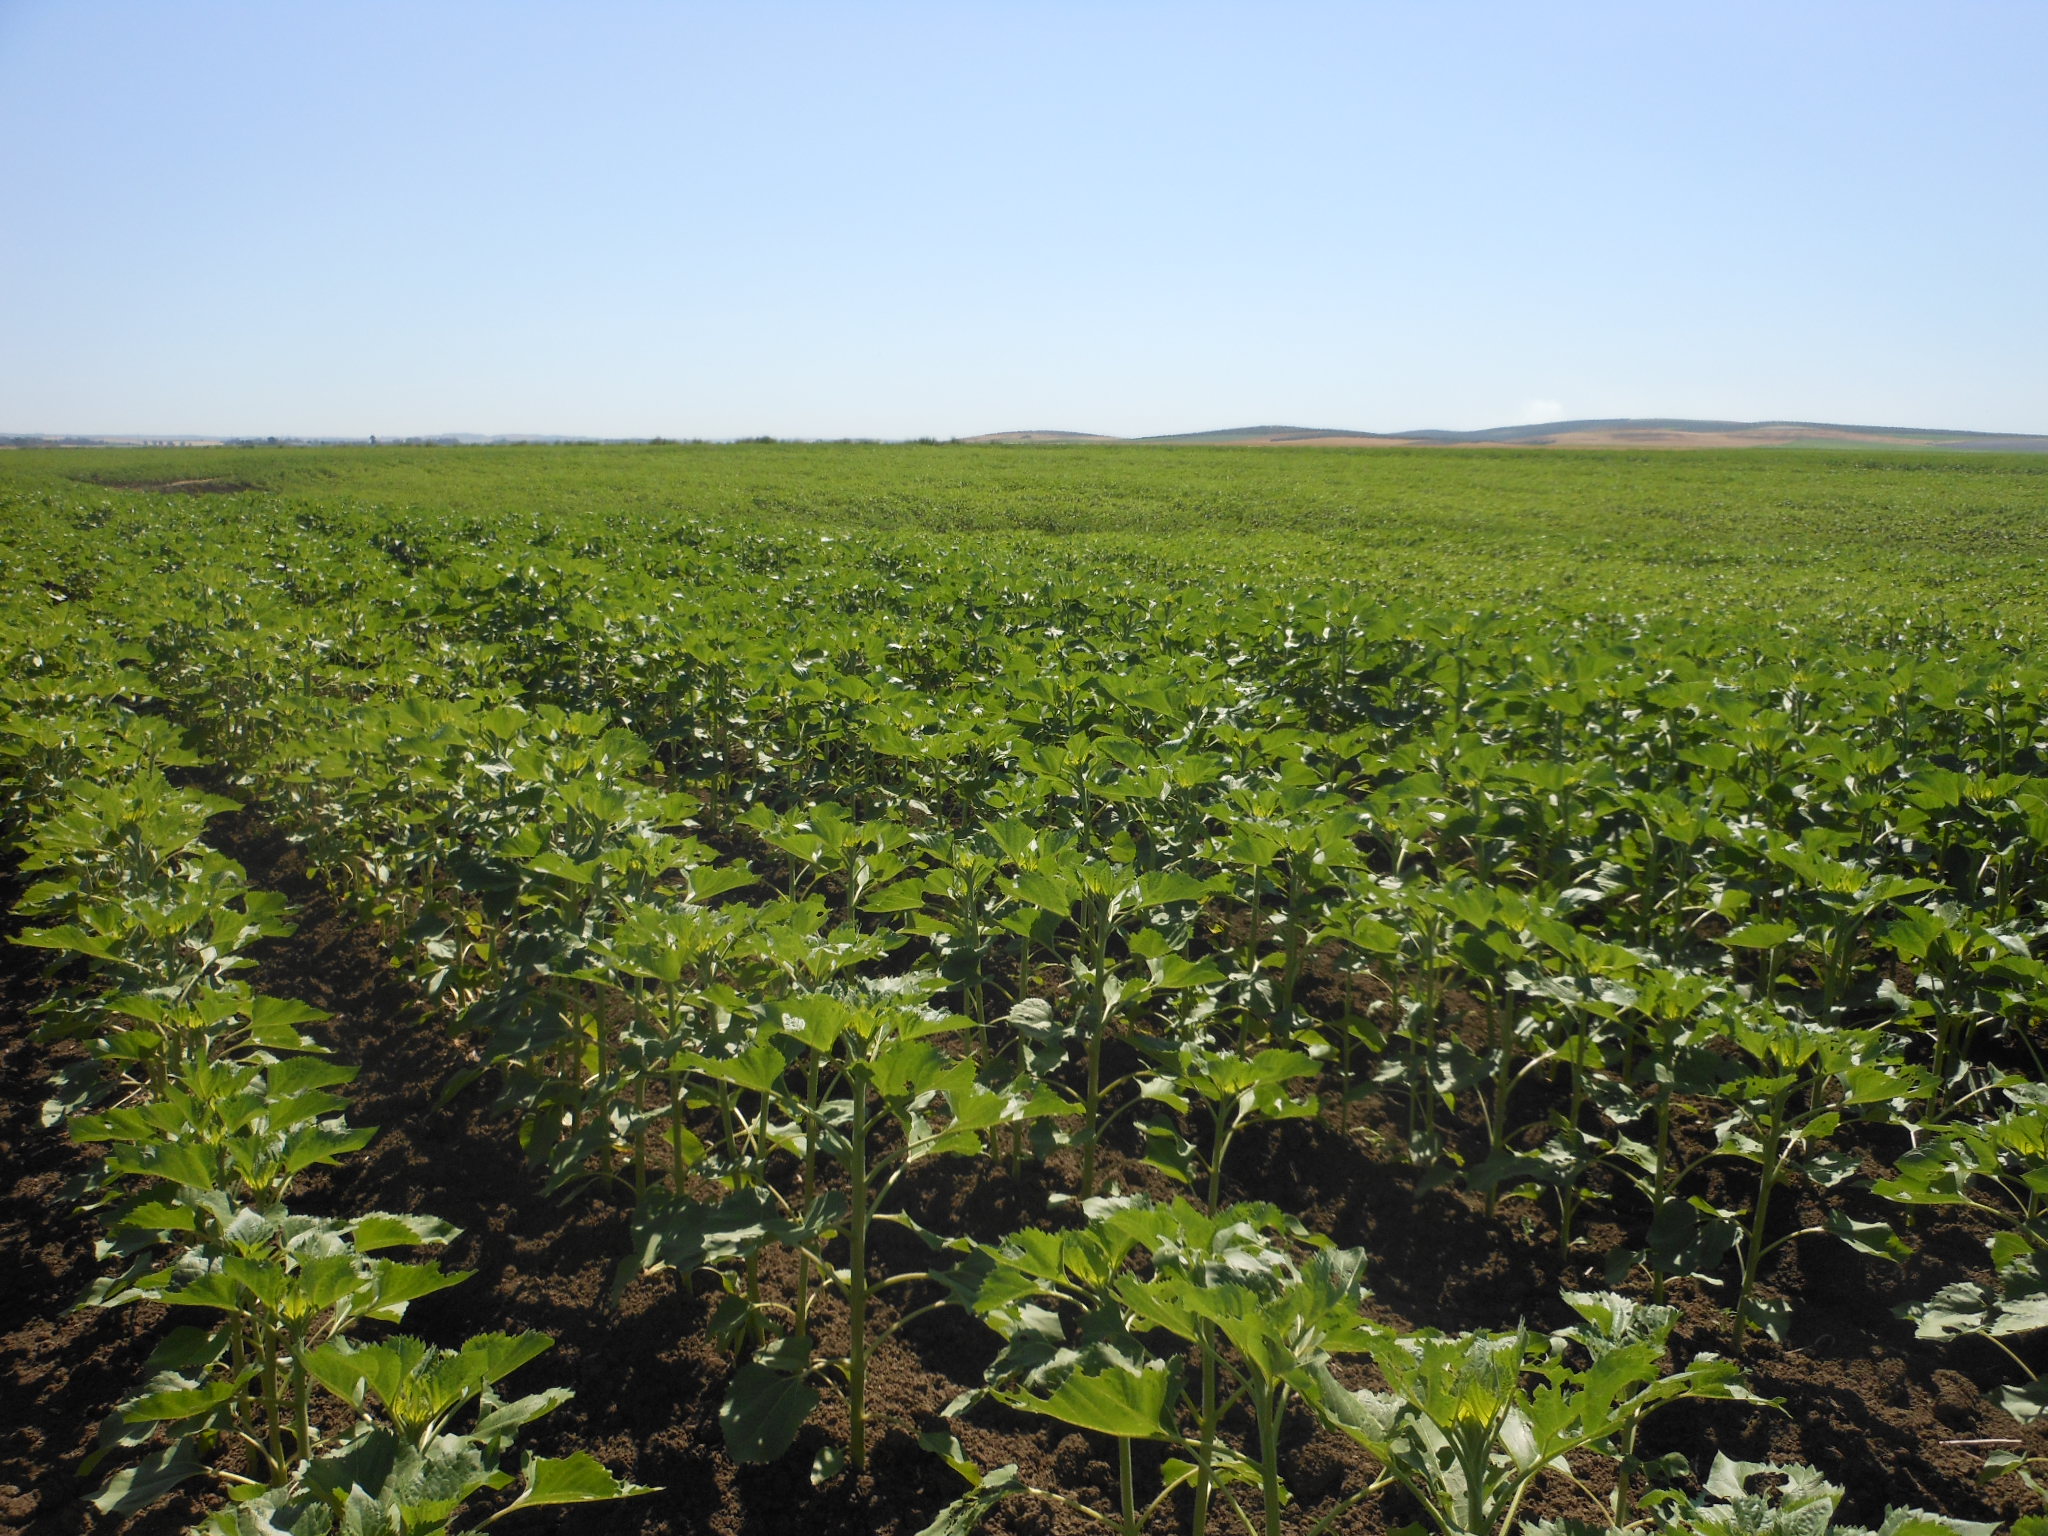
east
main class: Cropland
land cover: Sunflower
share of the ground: 25 - 50 %
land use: Agriculture (excluding fallow land and kitchen gardens)
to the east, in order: Sunflower; Grass margins; Durum wheat; Tracks; Sunflower
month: May
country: ES
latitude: 37.4277
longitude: -5.6018
